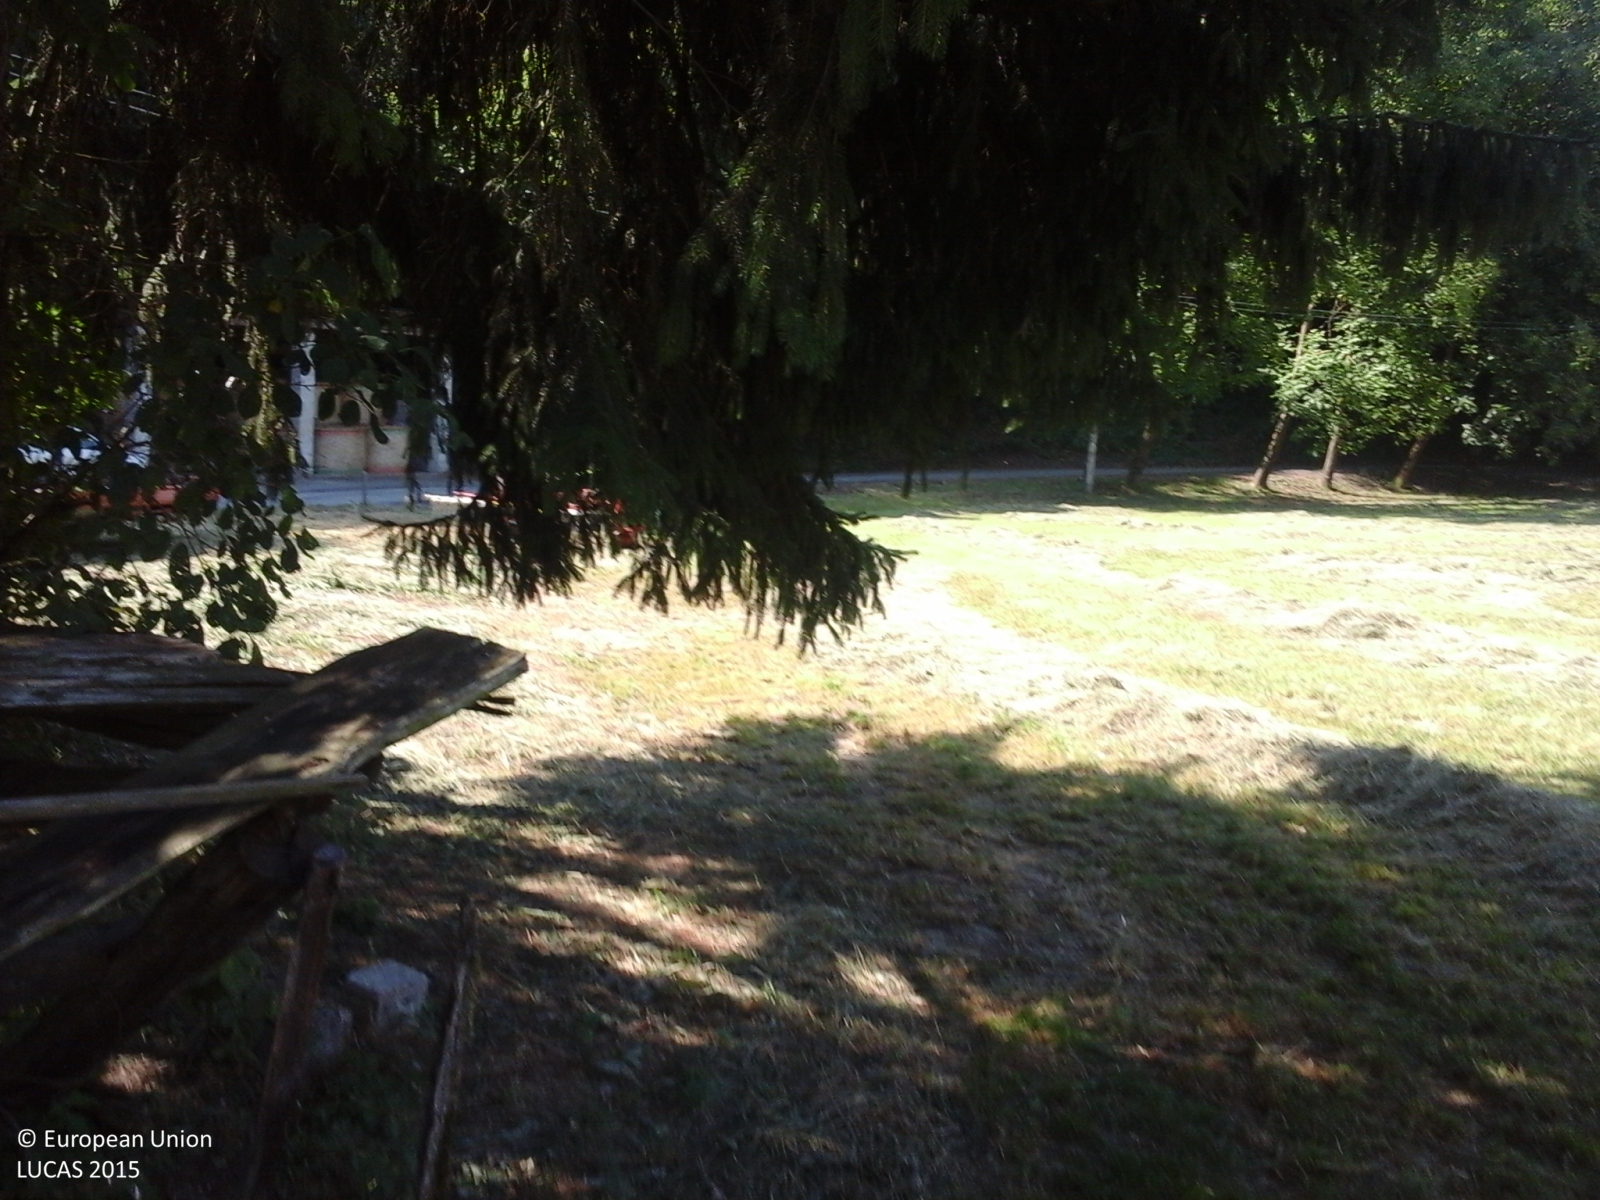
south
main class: Grassland
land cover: Grassland without tree/shrub cover
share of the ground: > 75 %
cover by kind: herbaceous plants 100 %
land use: Agriculture (excluding fallow land and kitchen gardens)
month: July
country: IT
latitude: 46.1710
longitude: 10.1164
